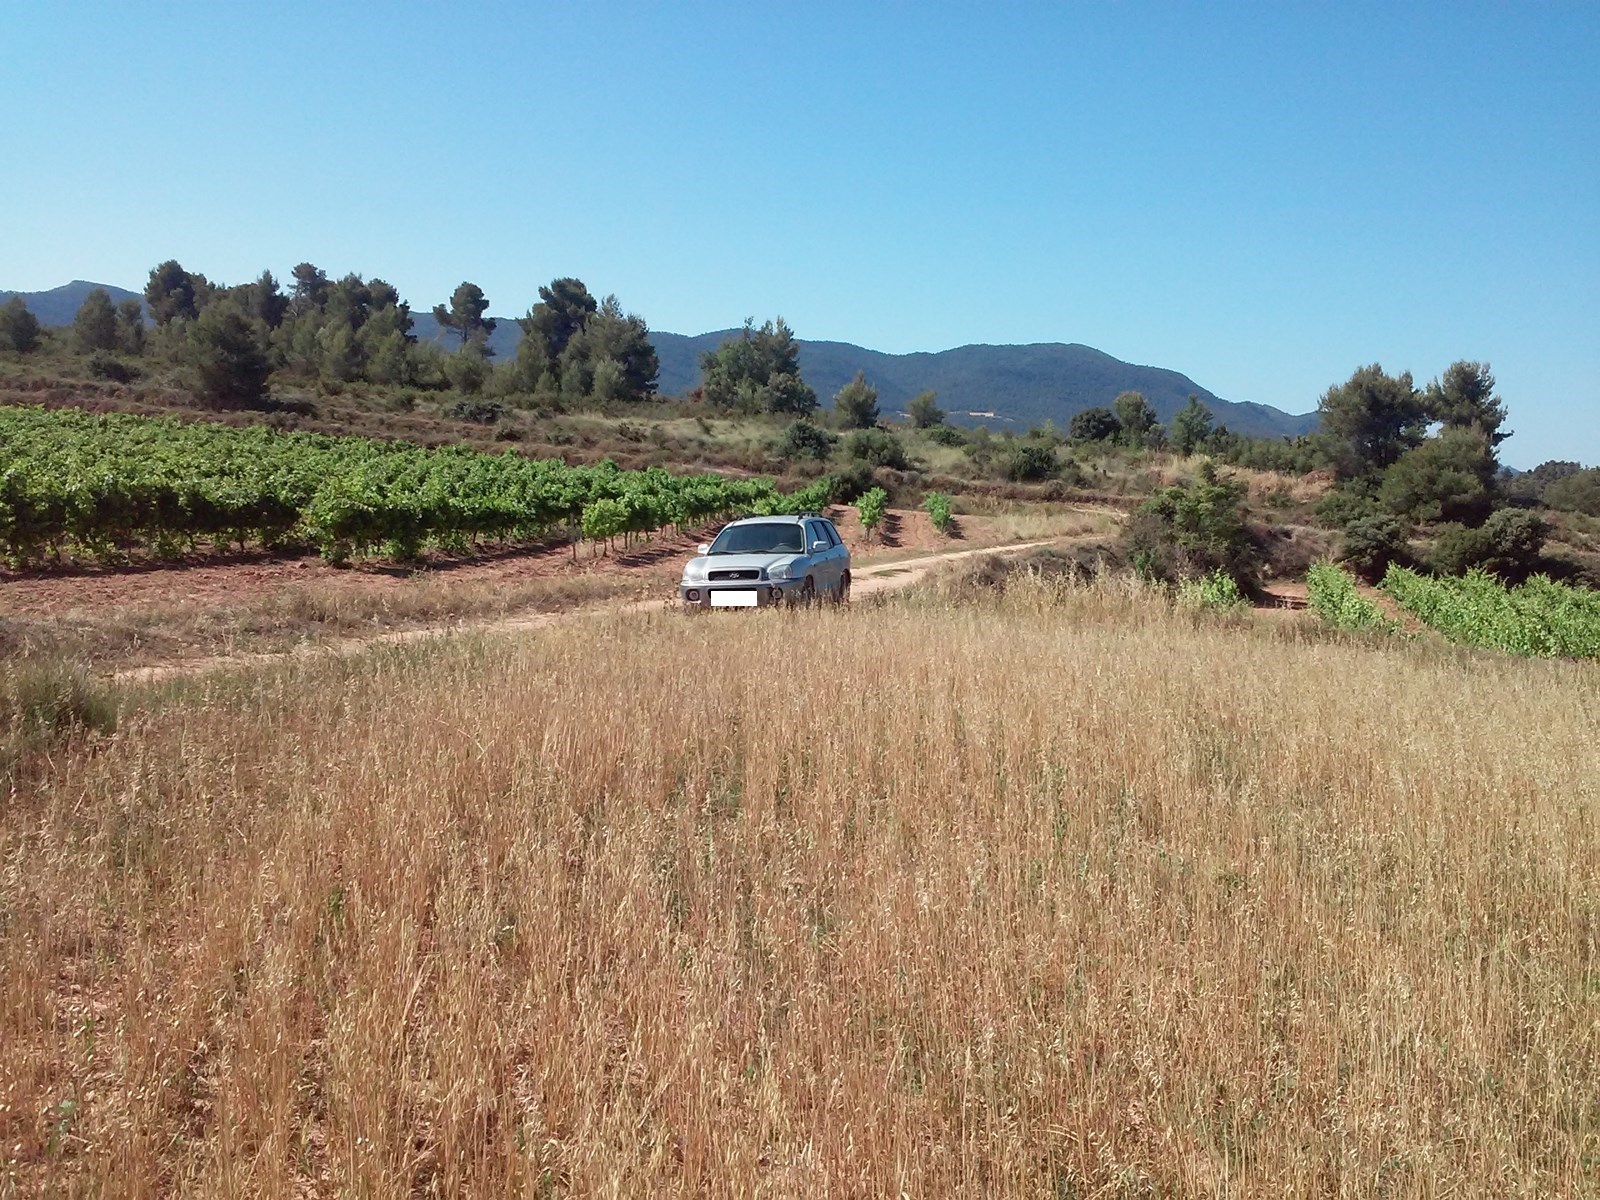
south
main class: Cropland
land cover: Oats
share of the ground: > 75 %
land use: Agriculture (excluding fallow land and kitchen gardens)
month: June
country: ES
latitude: 41.4207
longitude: 1.2453
